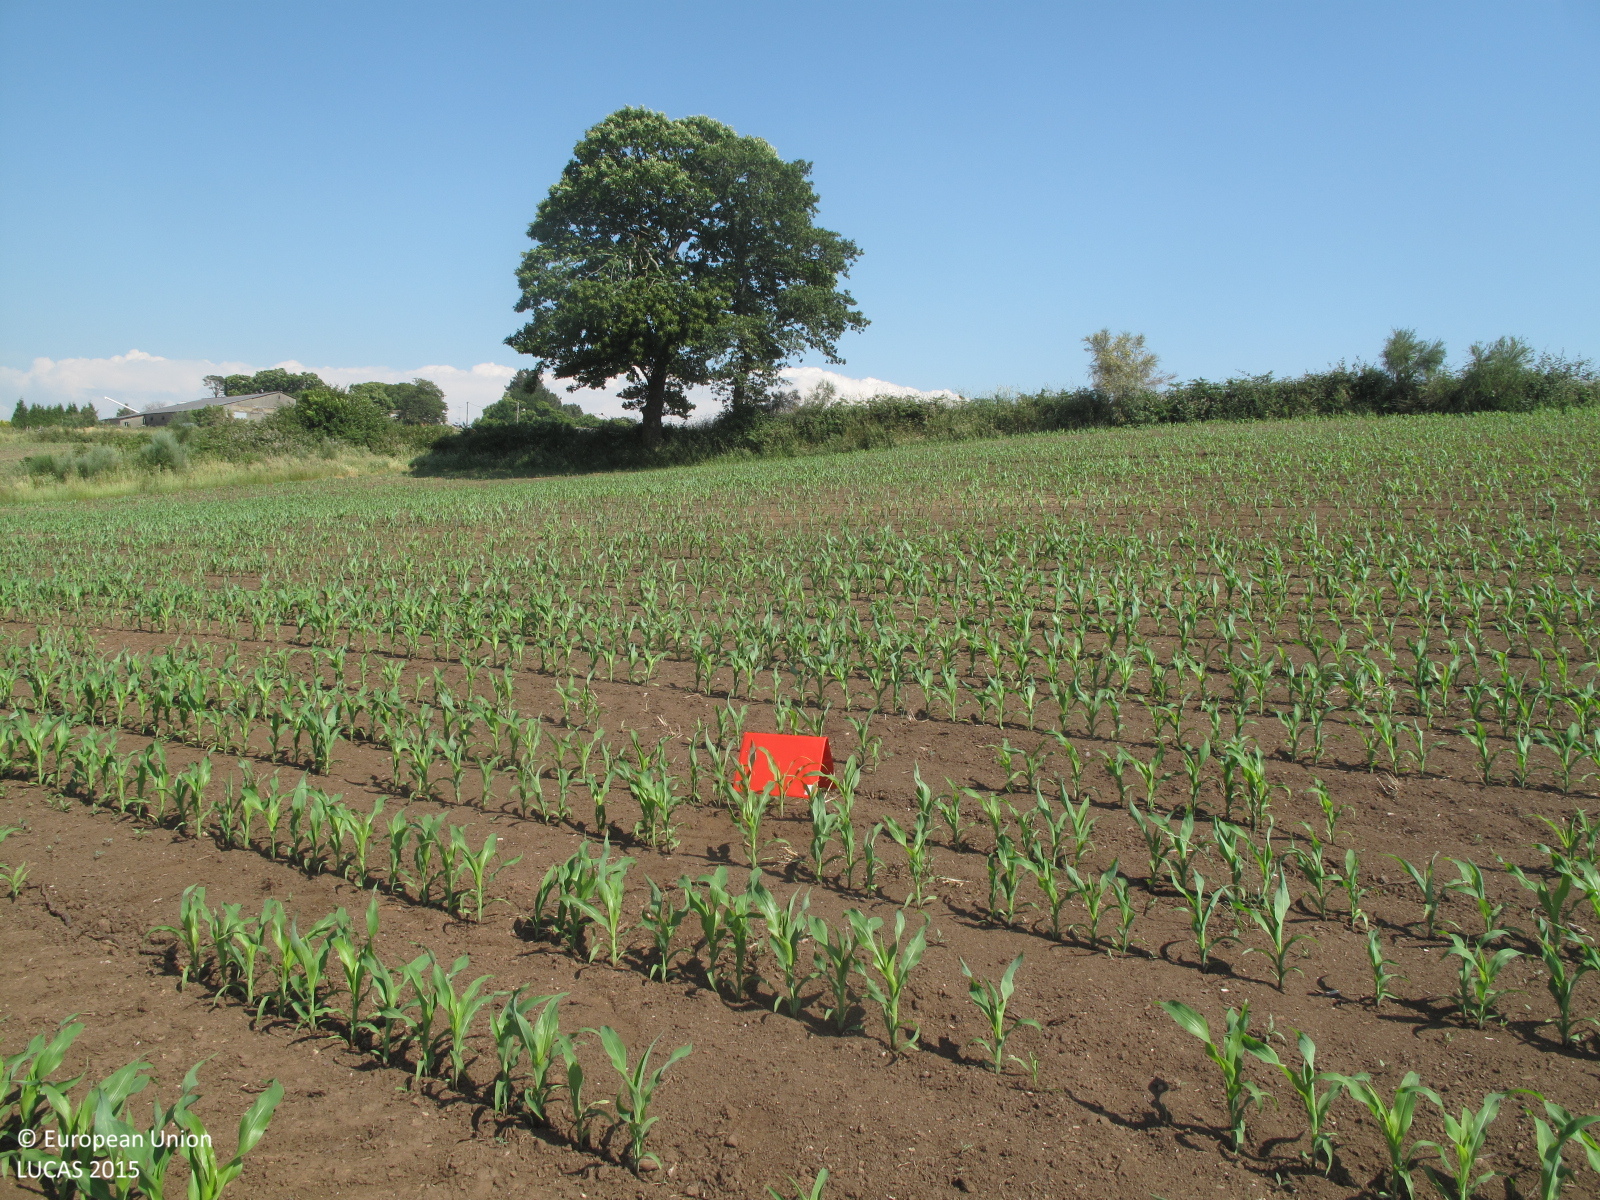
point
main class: Cropland
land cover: Maize
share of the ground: 10 - 25 %
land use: Agriculture (excluding fallow land and kitchen gardens)
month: June
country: ES
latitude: 43.2817
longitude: -7.9735
